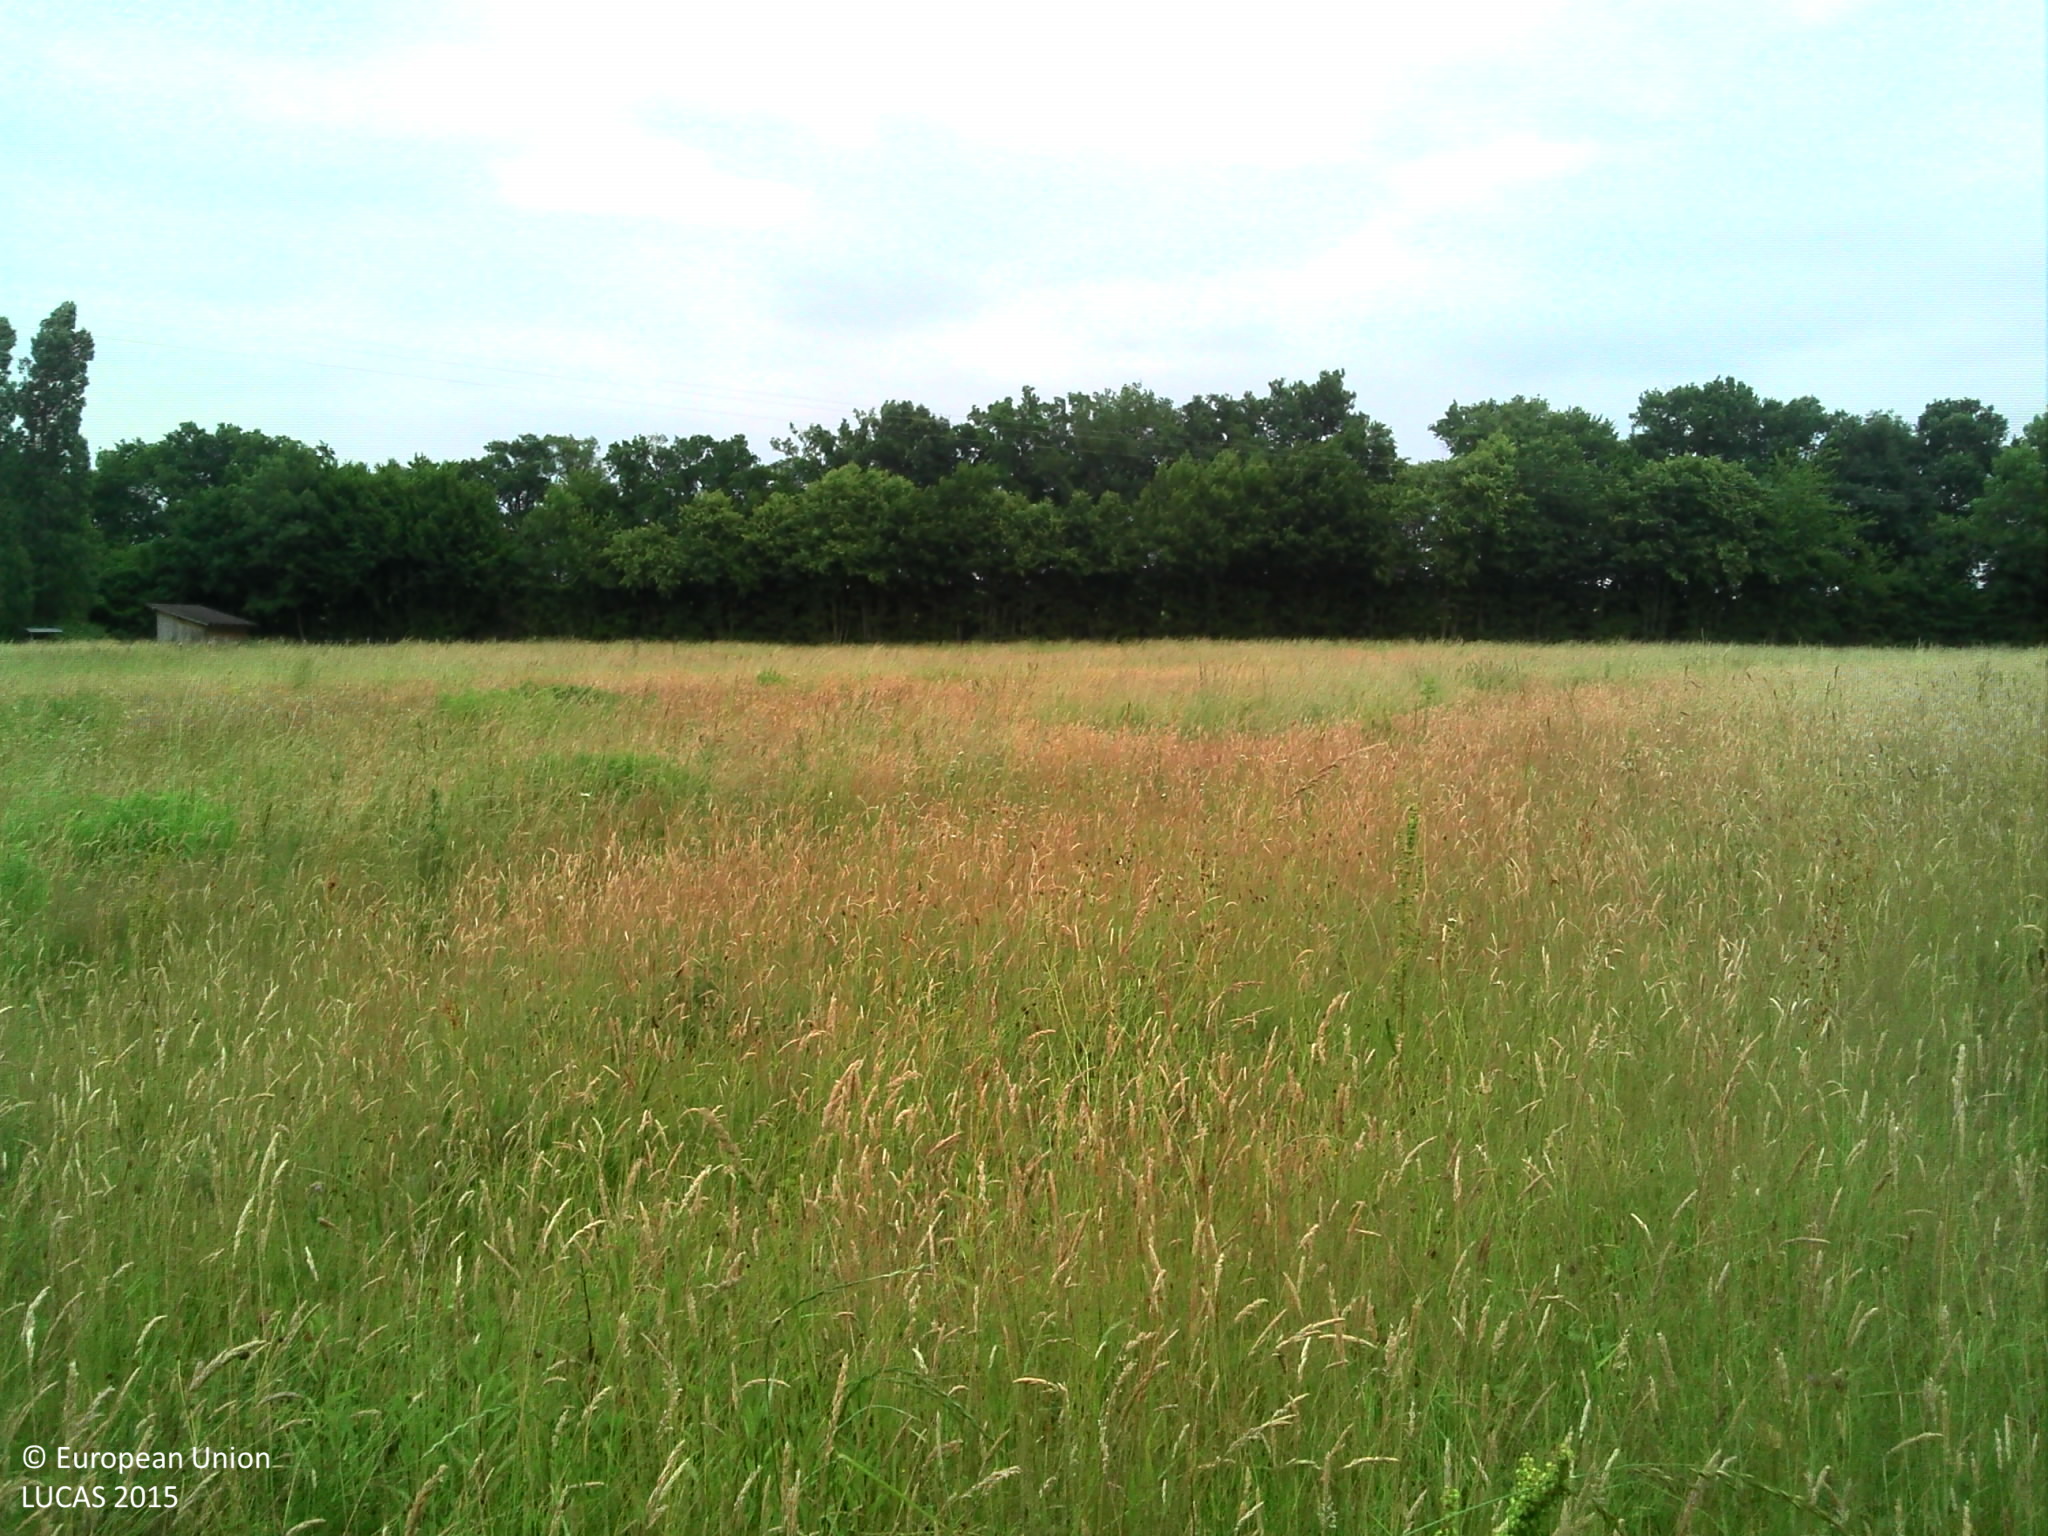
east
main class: Grassland
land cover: Grassland without tree/shrub cover
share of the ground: > 75 %
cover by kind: herbaceous plants 100 %
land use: Agriculture (excluding fallow land and kitchen gardens)
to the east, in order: Grassland without tree/shrub cover; Electric lines; Grassland without tree/shrub cover; Lines of trees; Grass margins; Shruby margins; Grass margins; Ditches and canals; Lines of trees; Maize
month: June
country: FR
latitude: 46.1029
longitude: 4.8929
